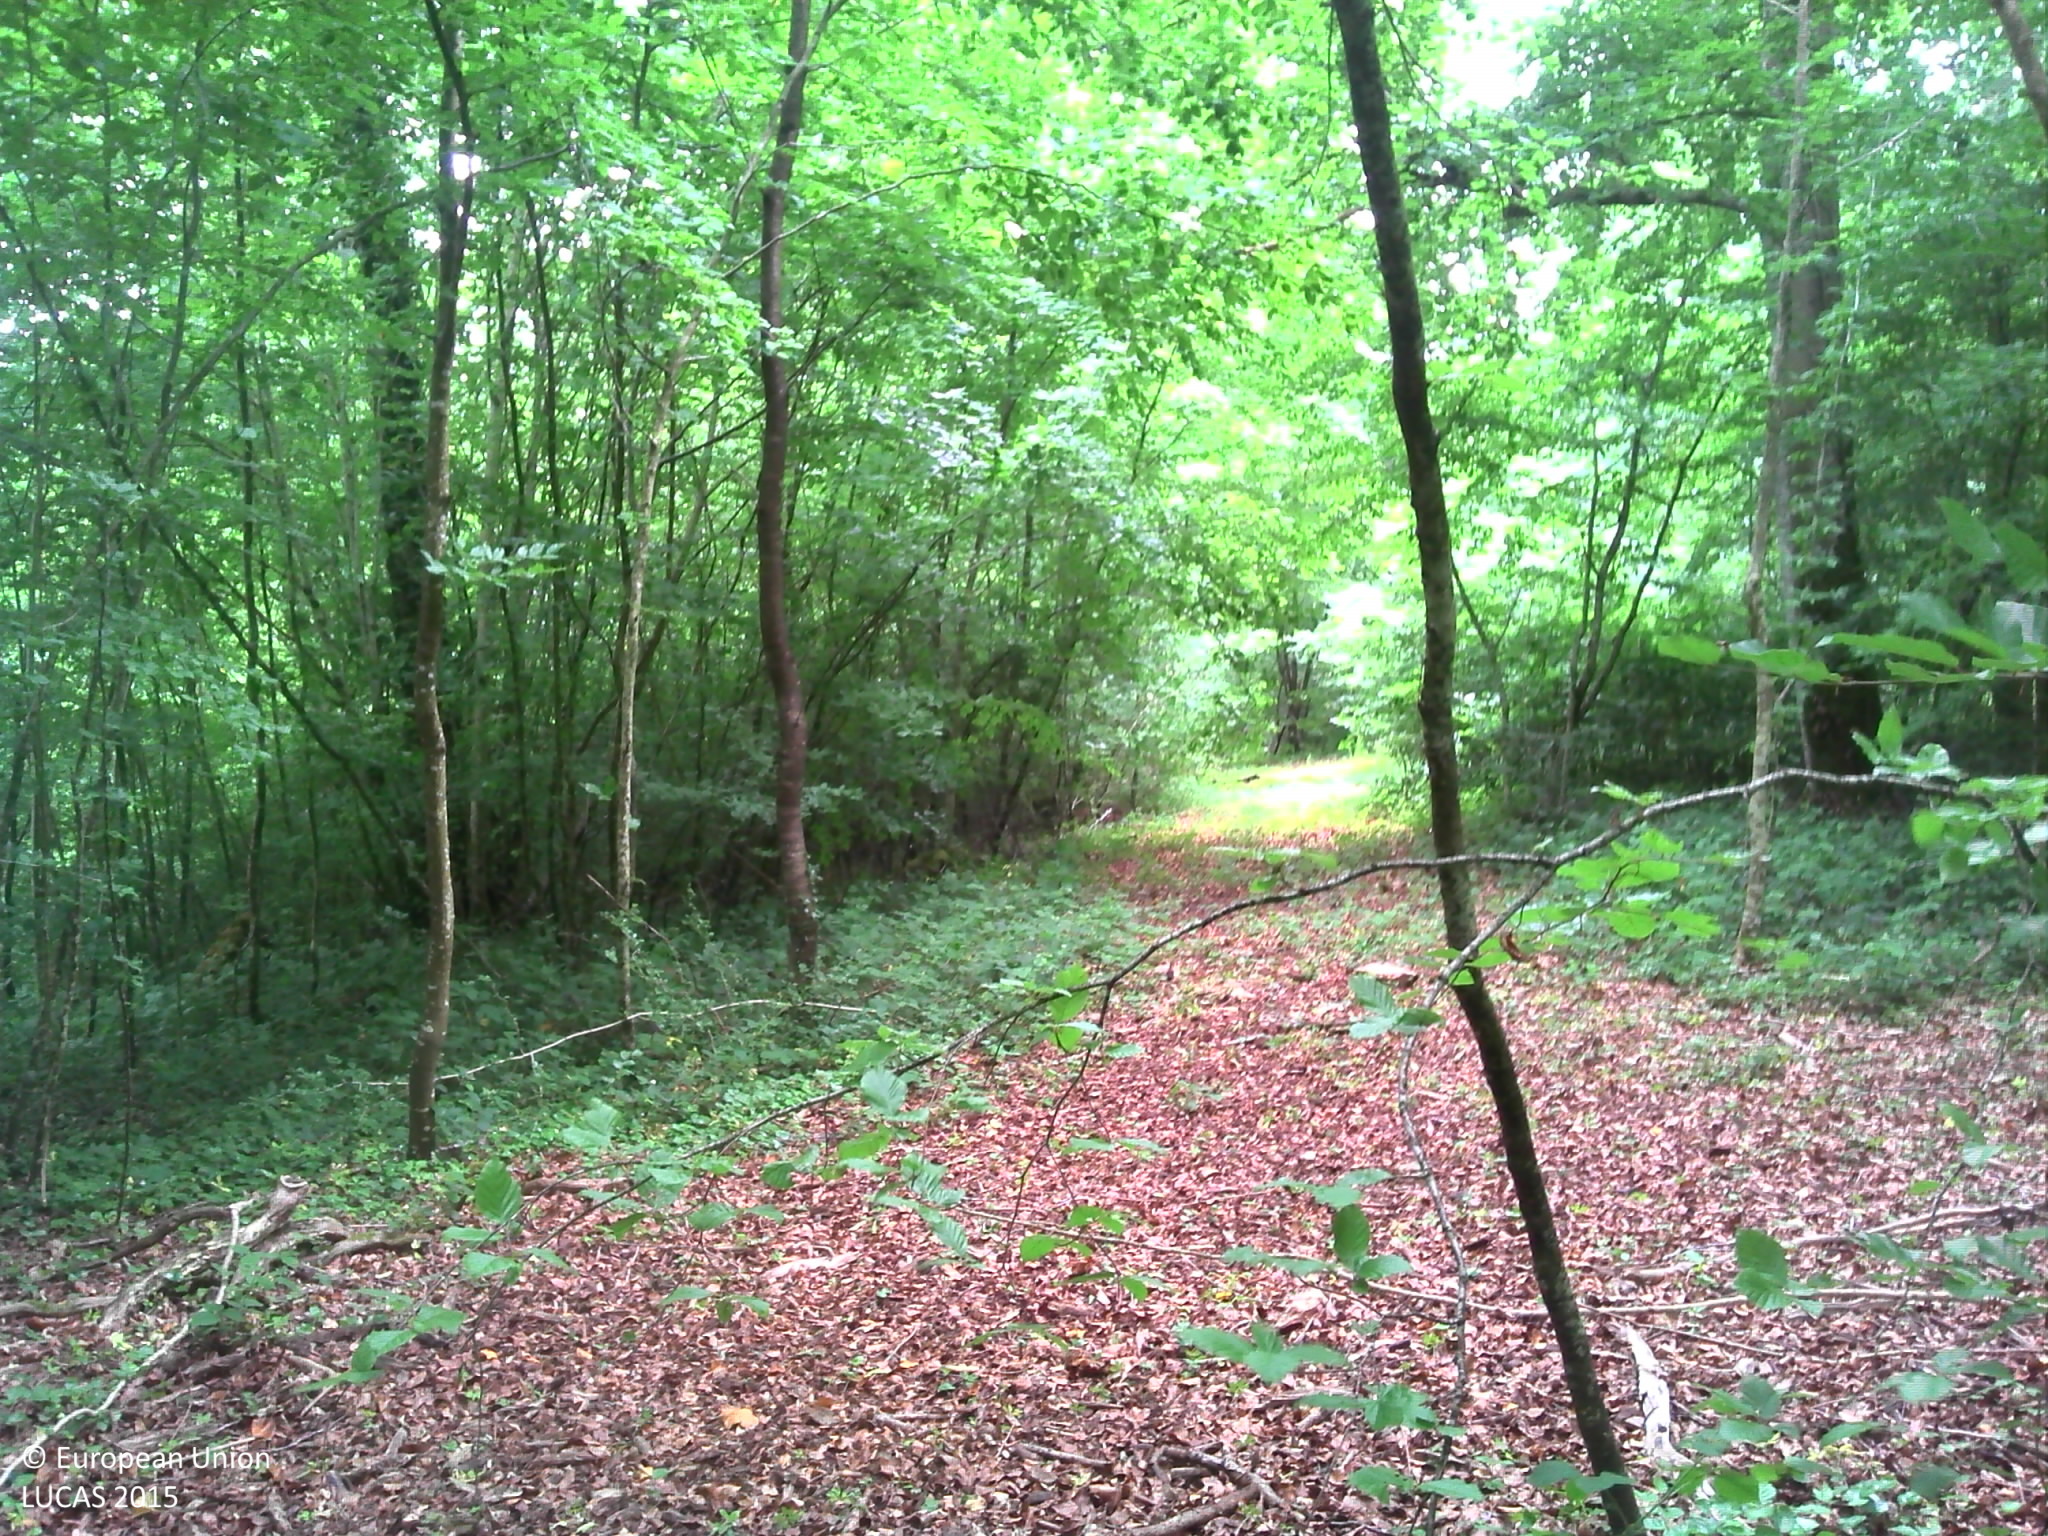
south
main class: Woodland
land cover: Broadleaved woodland
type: beech forest
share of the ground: > 75 %
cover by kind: broadleaved forest trees 90 %, herbaceous plants 10 %
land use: Forestry
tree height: > 5 m
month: June
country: FR
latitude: 48.3597
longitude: 4.9373
